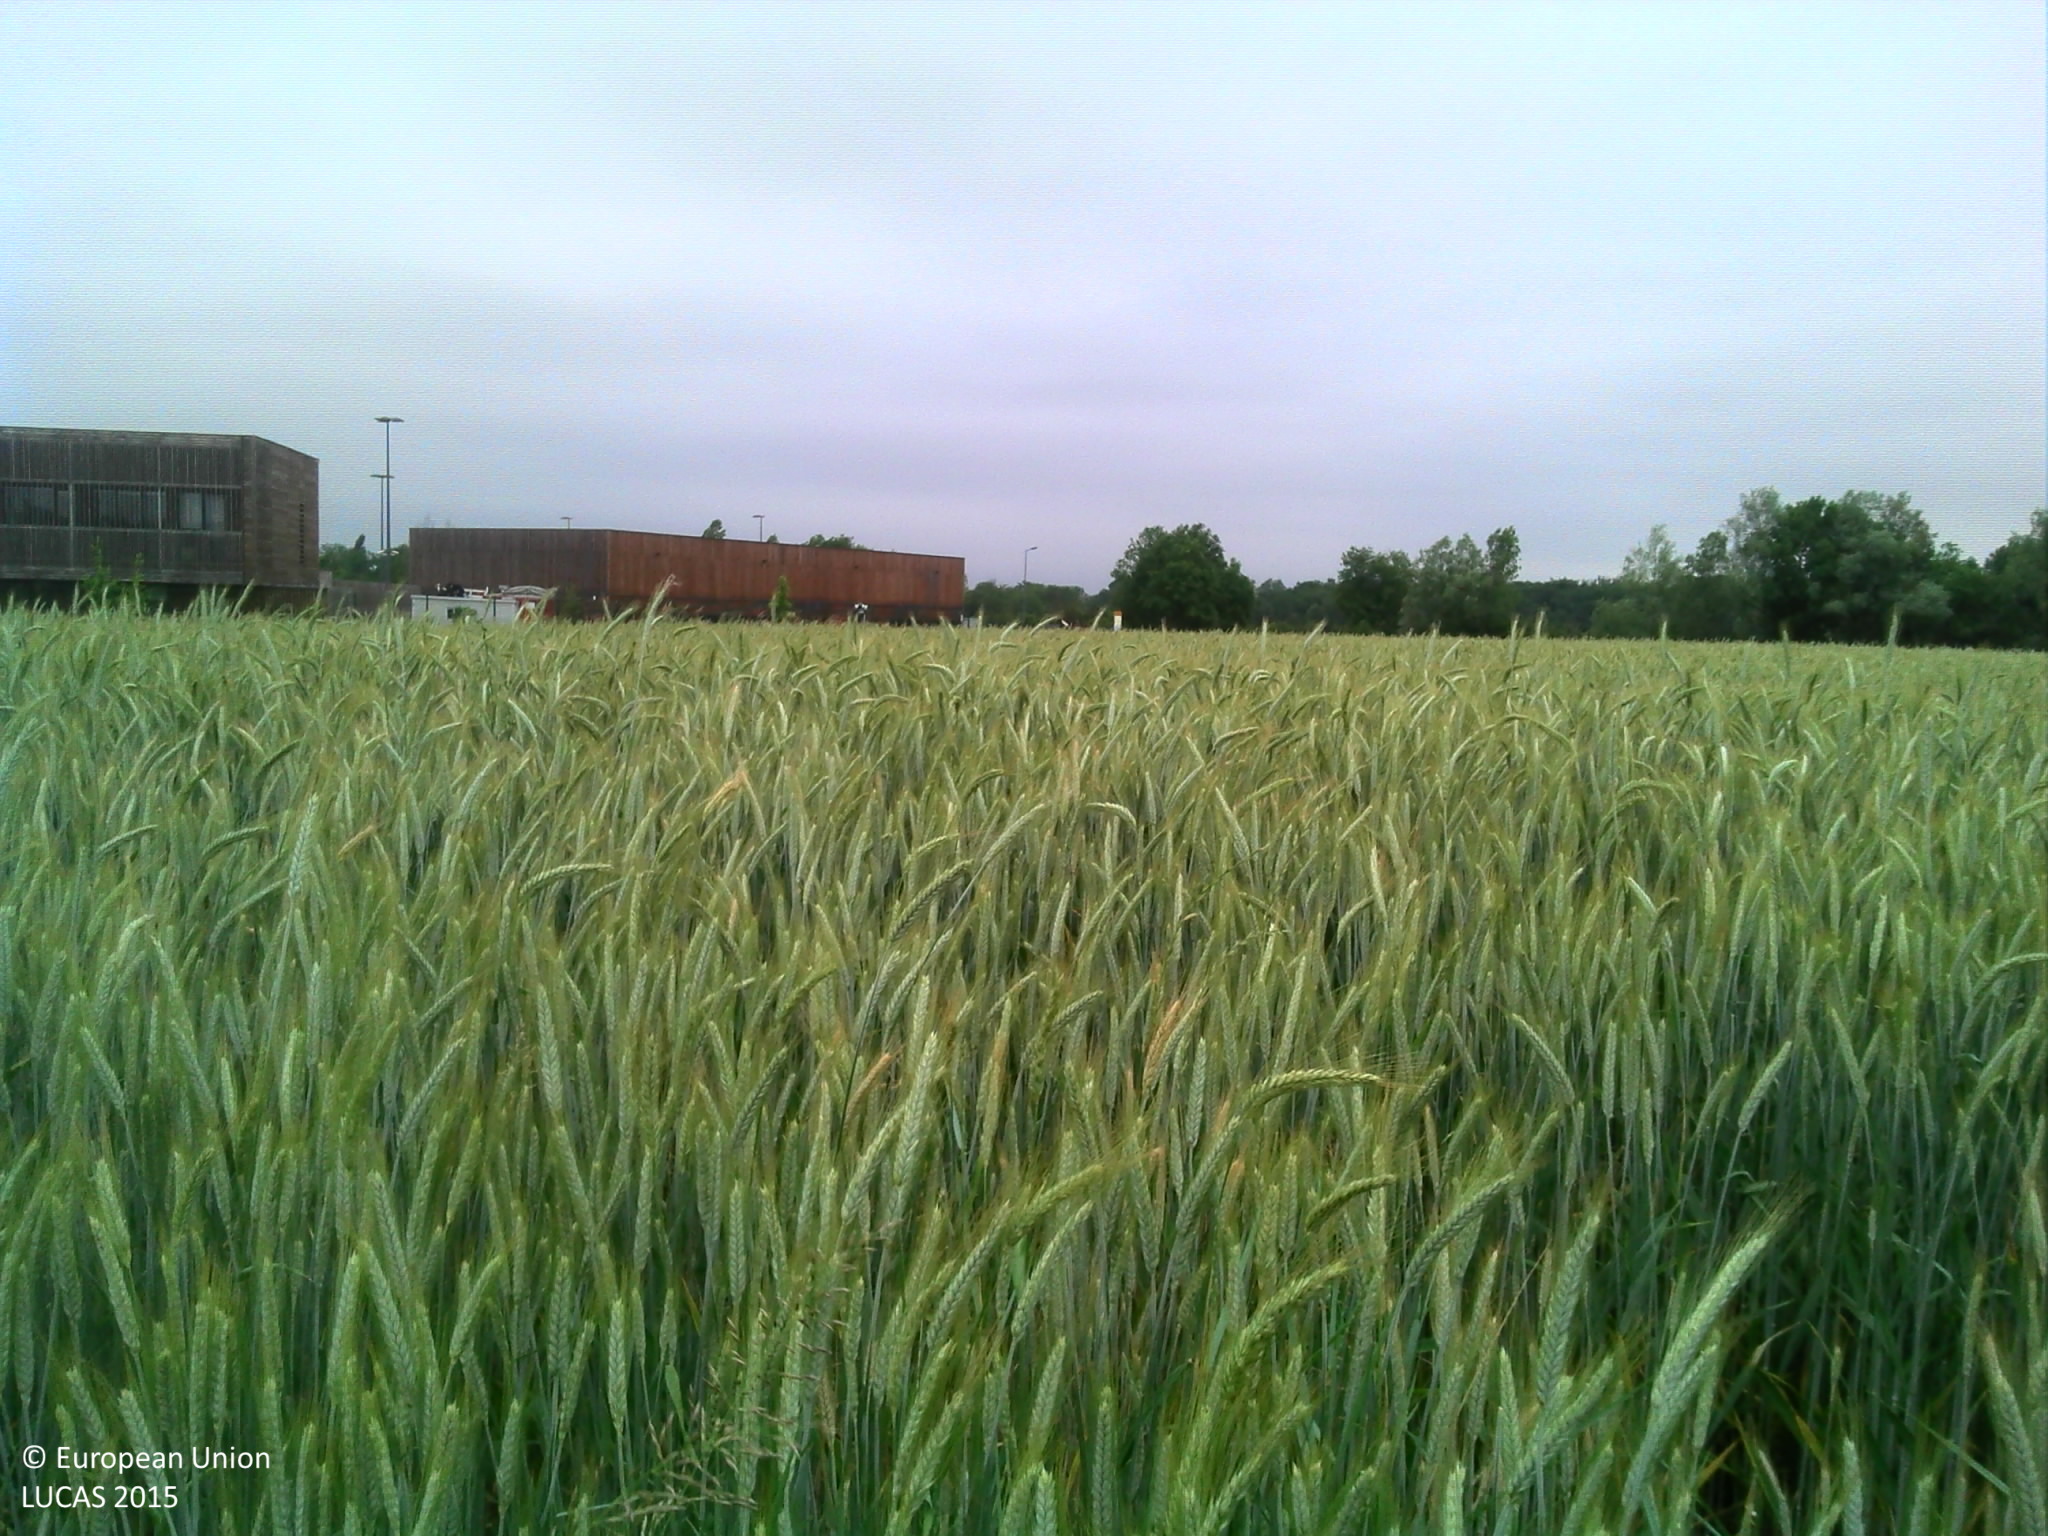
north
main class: Shrubland
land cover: Shrubland with sparse tree cover
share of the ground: > 75 %
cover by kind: shrubs 95 %, broadleaved forest trees 5 %
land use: Fallow land
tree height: < 5 m
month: May
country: FR
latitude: 43.7653
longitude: 1.7175
